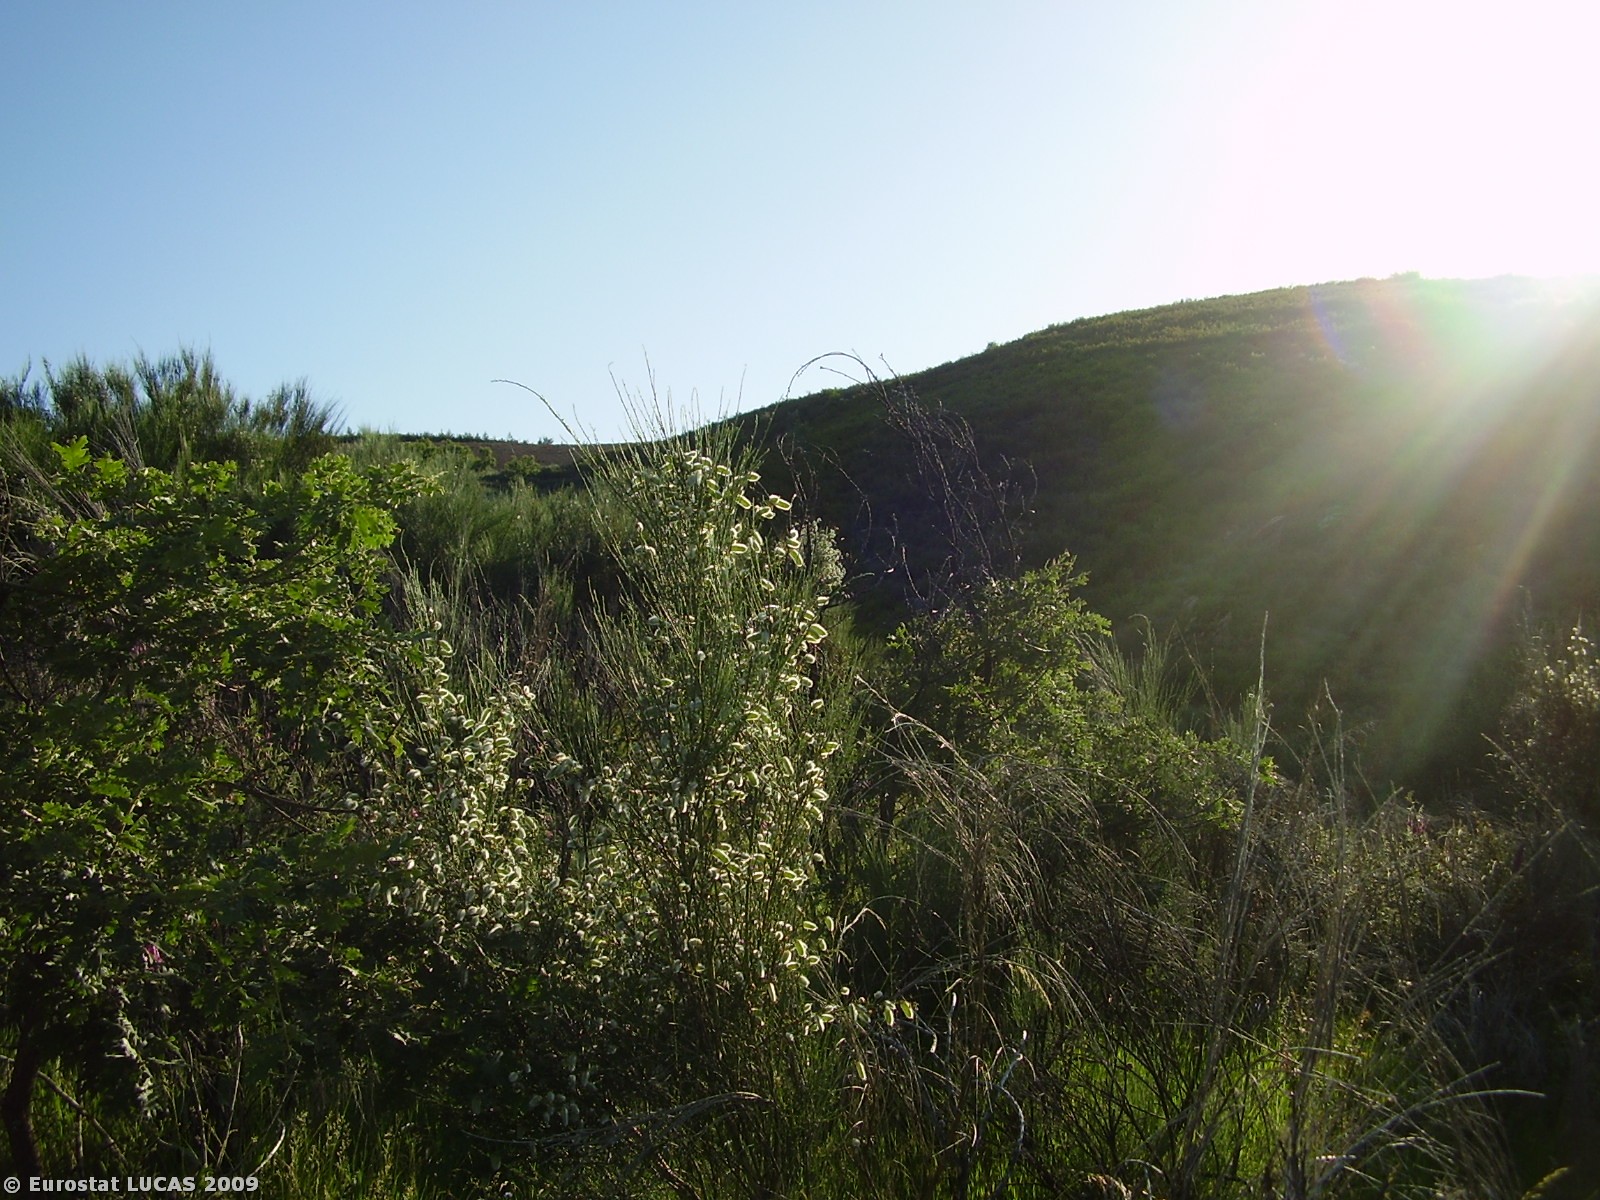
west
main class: Grassland
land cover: Spontaneously vegetated surfaces
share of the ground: > 75 %
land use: Nature reserves
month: June
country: PT
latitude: 41.9108
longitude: -6.9619
